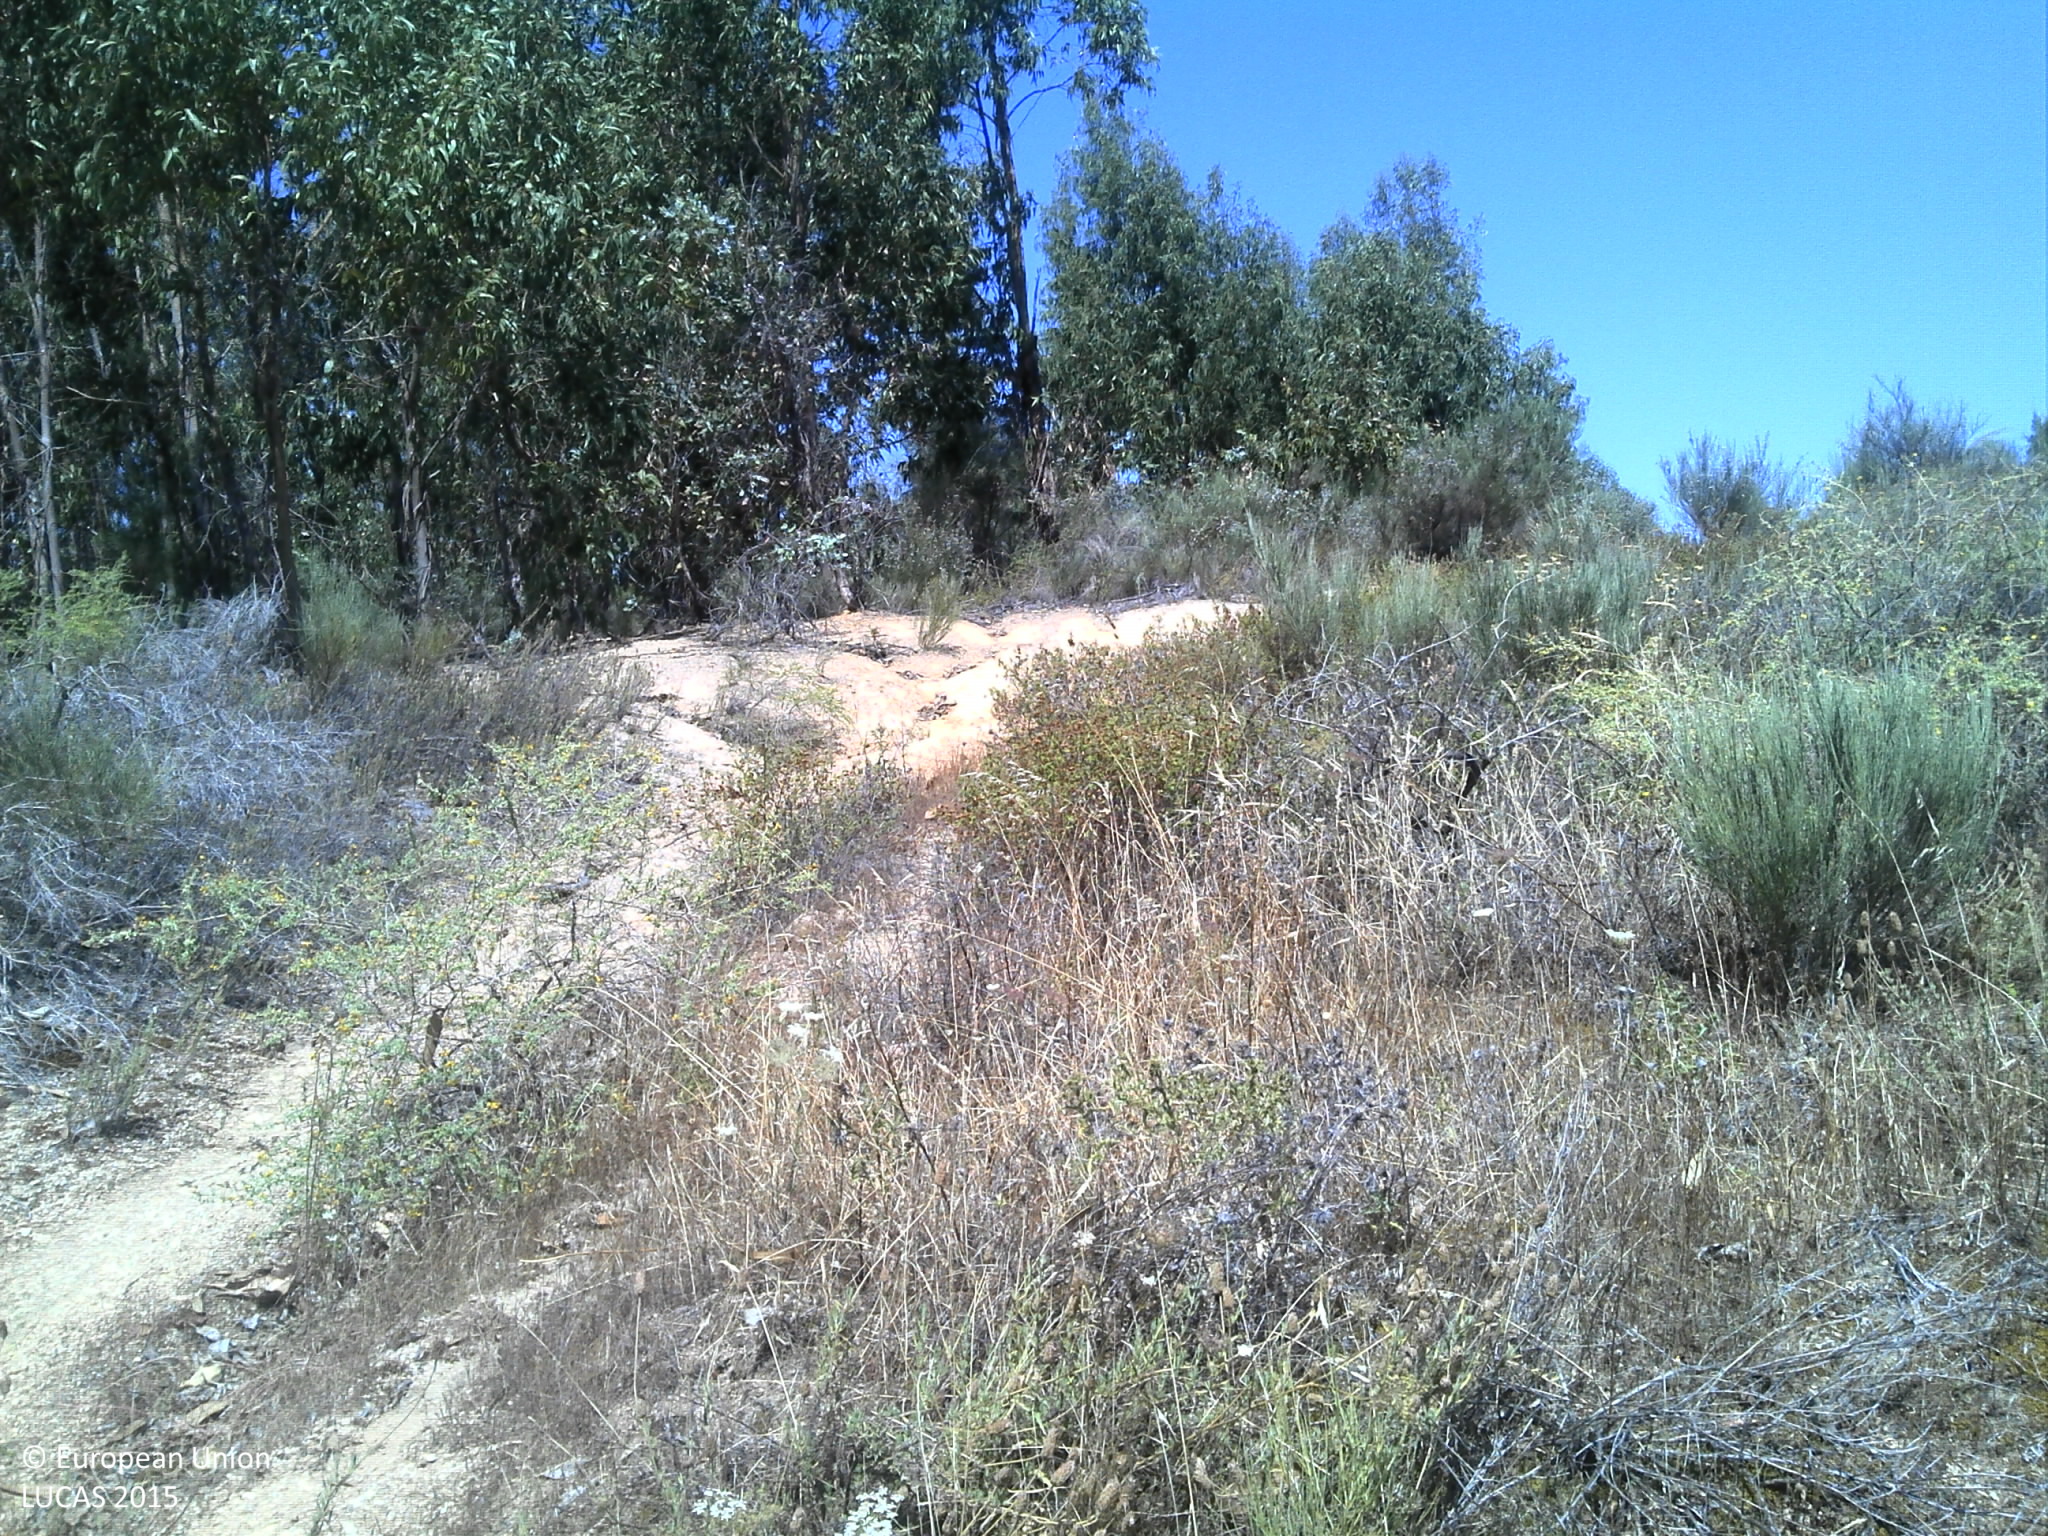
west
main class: Woodland
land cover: Broadleaved woodland
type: exotic forest
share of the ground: 25 - 50 %
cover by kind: broadleaved forest trees 50 %, shrubs 20 %, unconsolidated bare surface 15 %, herbaceous plants 10 %
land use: Forestry
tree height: > 5 m
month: June
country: PT
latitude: 40.0469
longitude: -7.2933
